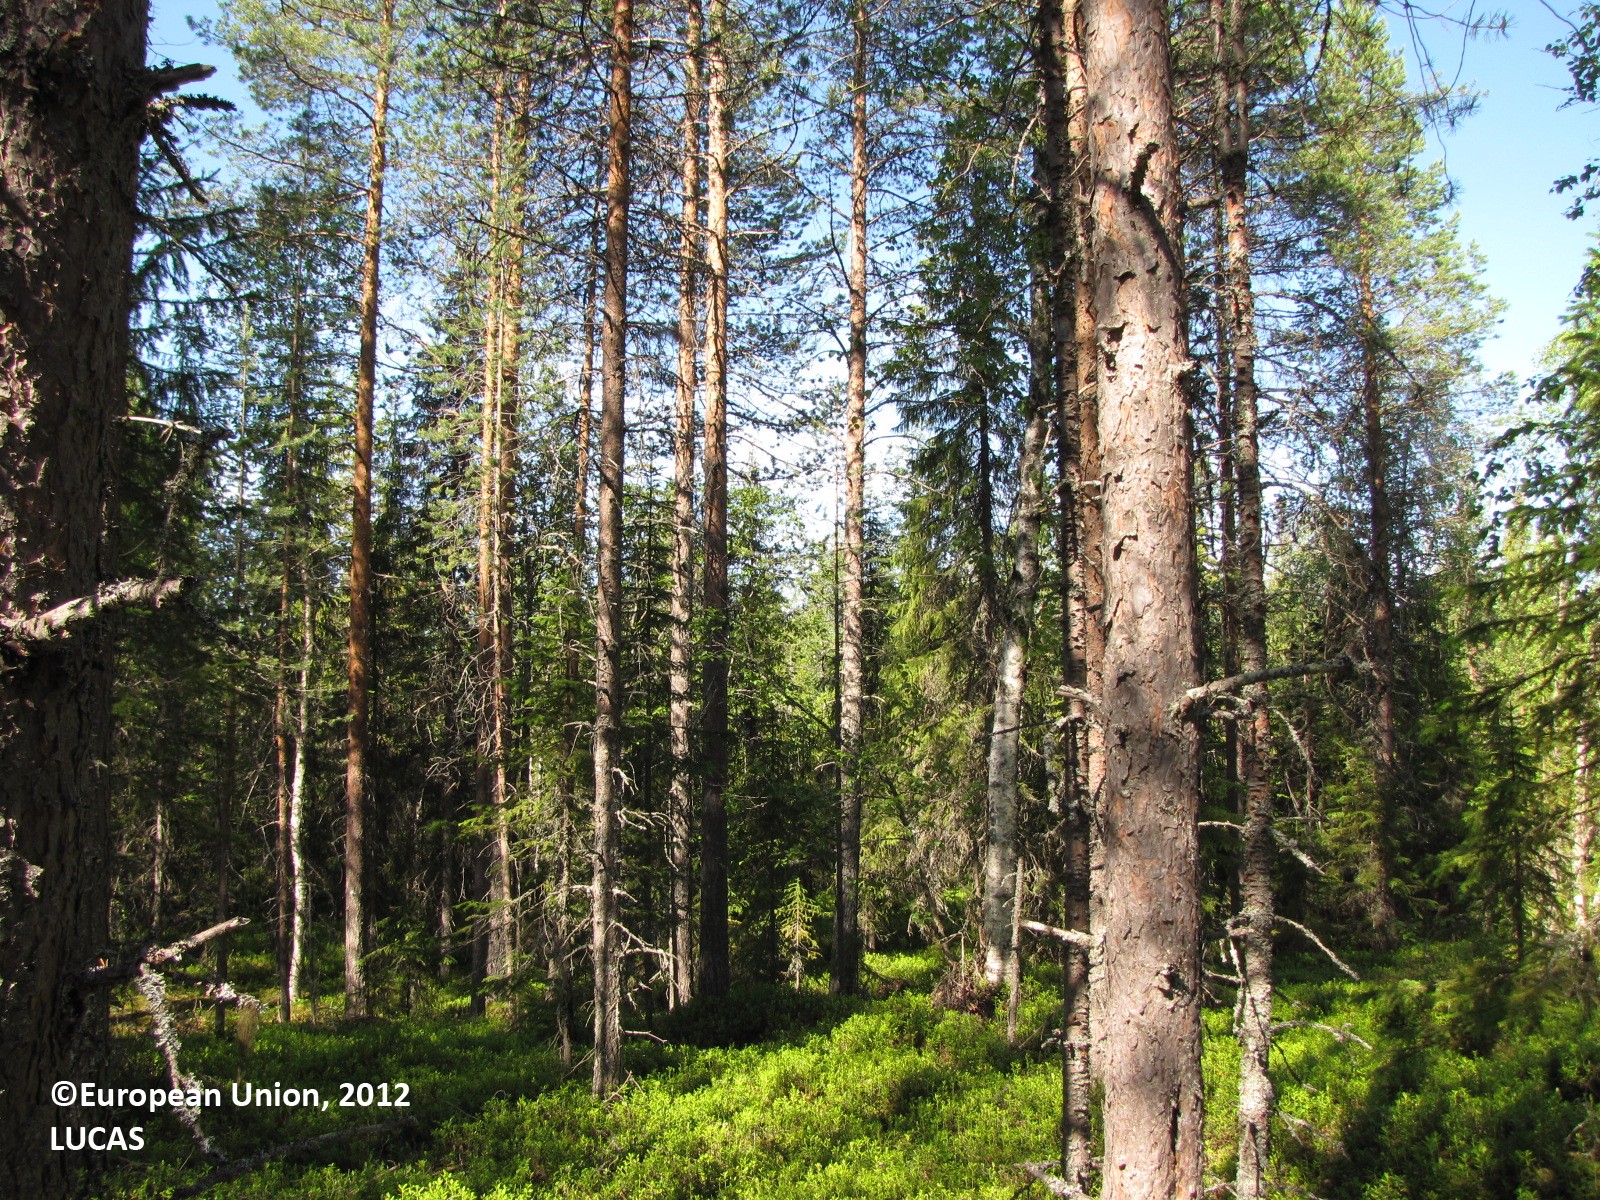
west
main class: Woodland
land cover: Pine dominated coniferous woodland
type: boreal forest
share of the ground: 50 - 75 %
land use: Forestry
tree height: > 5 m
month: July
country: FI
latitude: 66.3704
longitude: 25.2870
